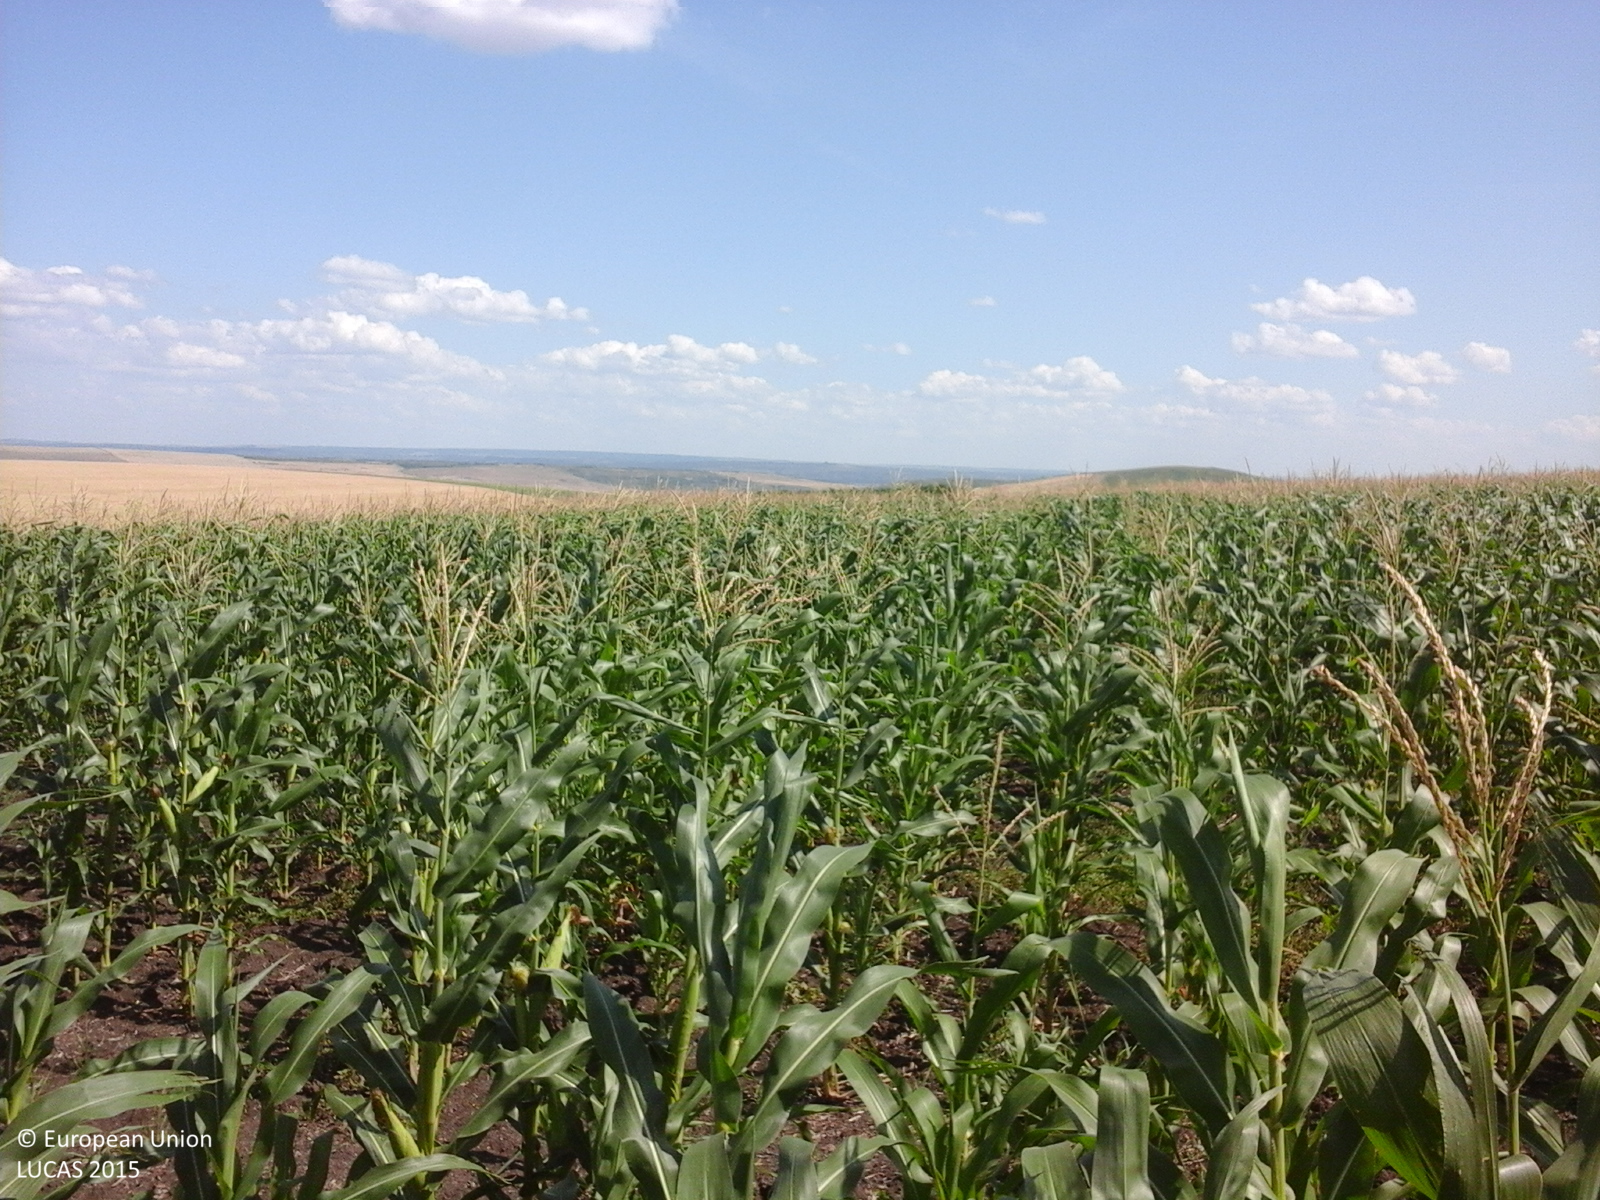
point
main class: Cropland
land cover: Maize
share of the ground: > 75 %
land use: Agriculture (excluding fallow land and kitchen gardens)
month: July
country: RO
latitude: 46.4705
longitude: 28.0880
